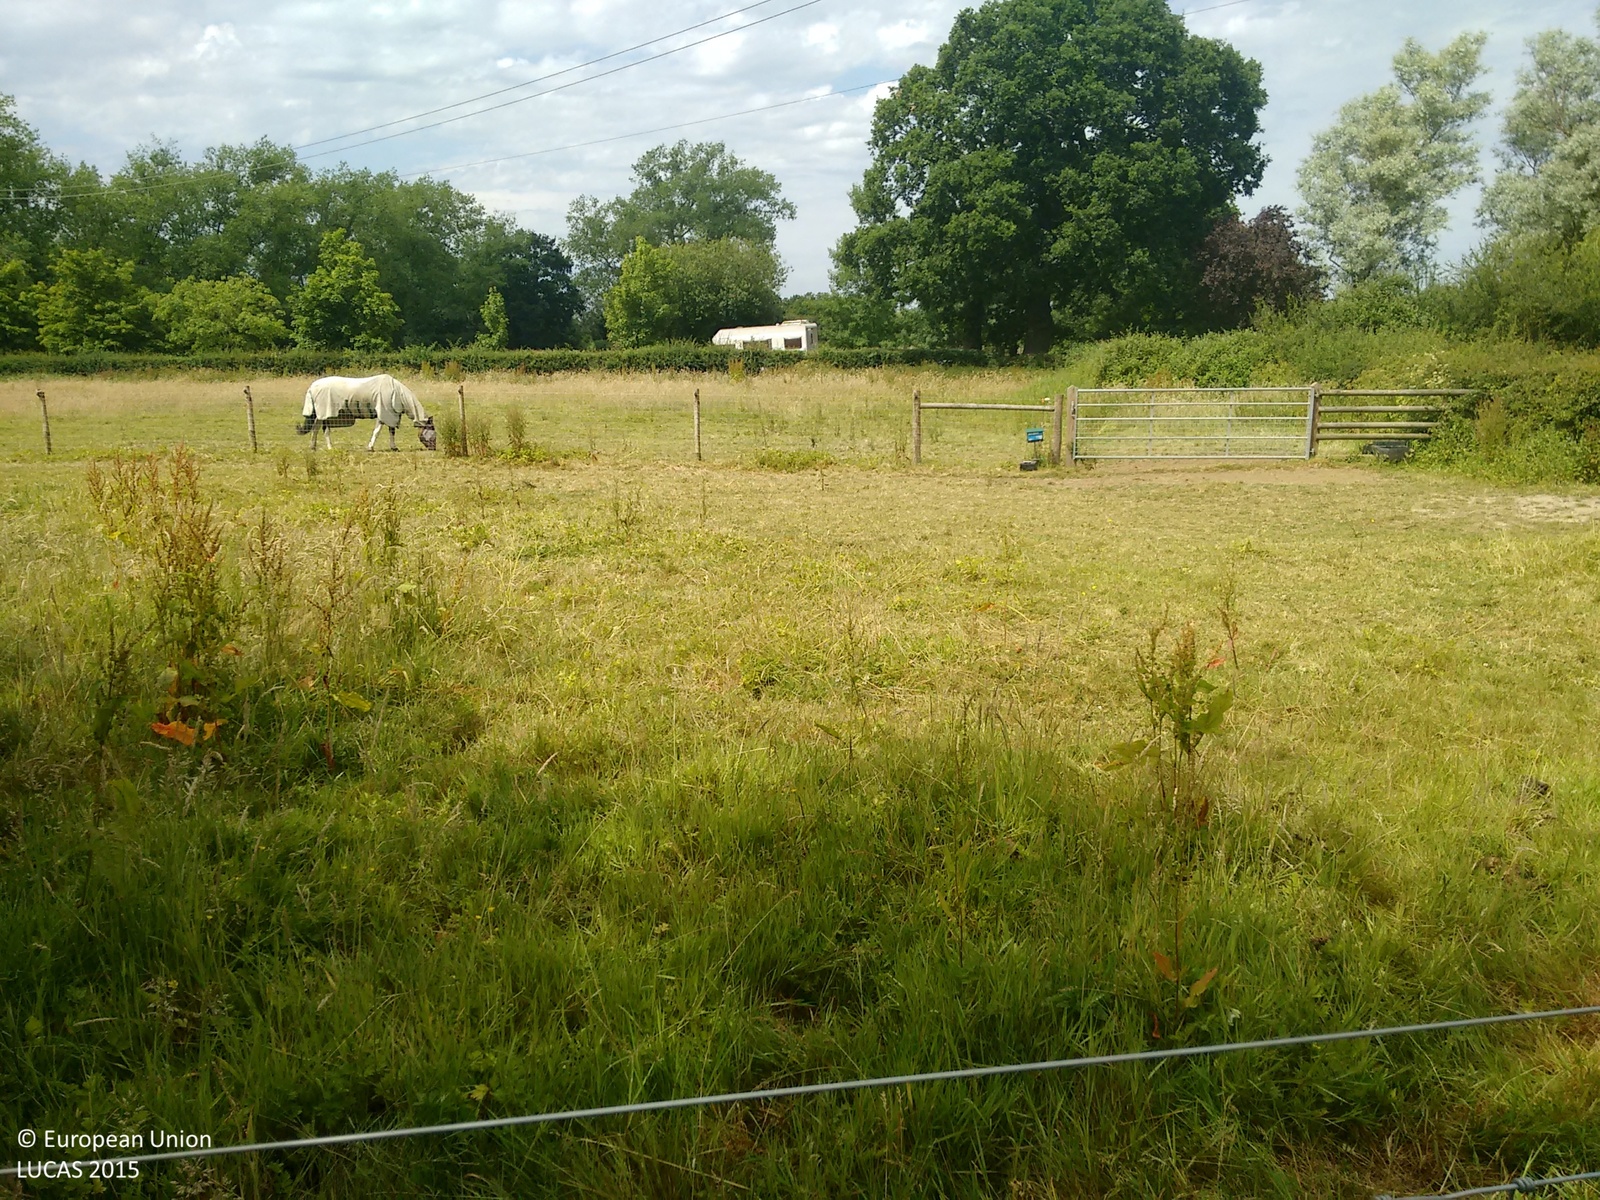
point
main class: Grassland
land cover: Grassland without tree/shrub cover
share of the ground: > 75 %
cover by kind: herbaceous plants 100 %
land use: Agriculture (excluding fallow land and kitchen gardens)
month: July
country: GB
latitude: 50.9569
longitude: -0.2142
